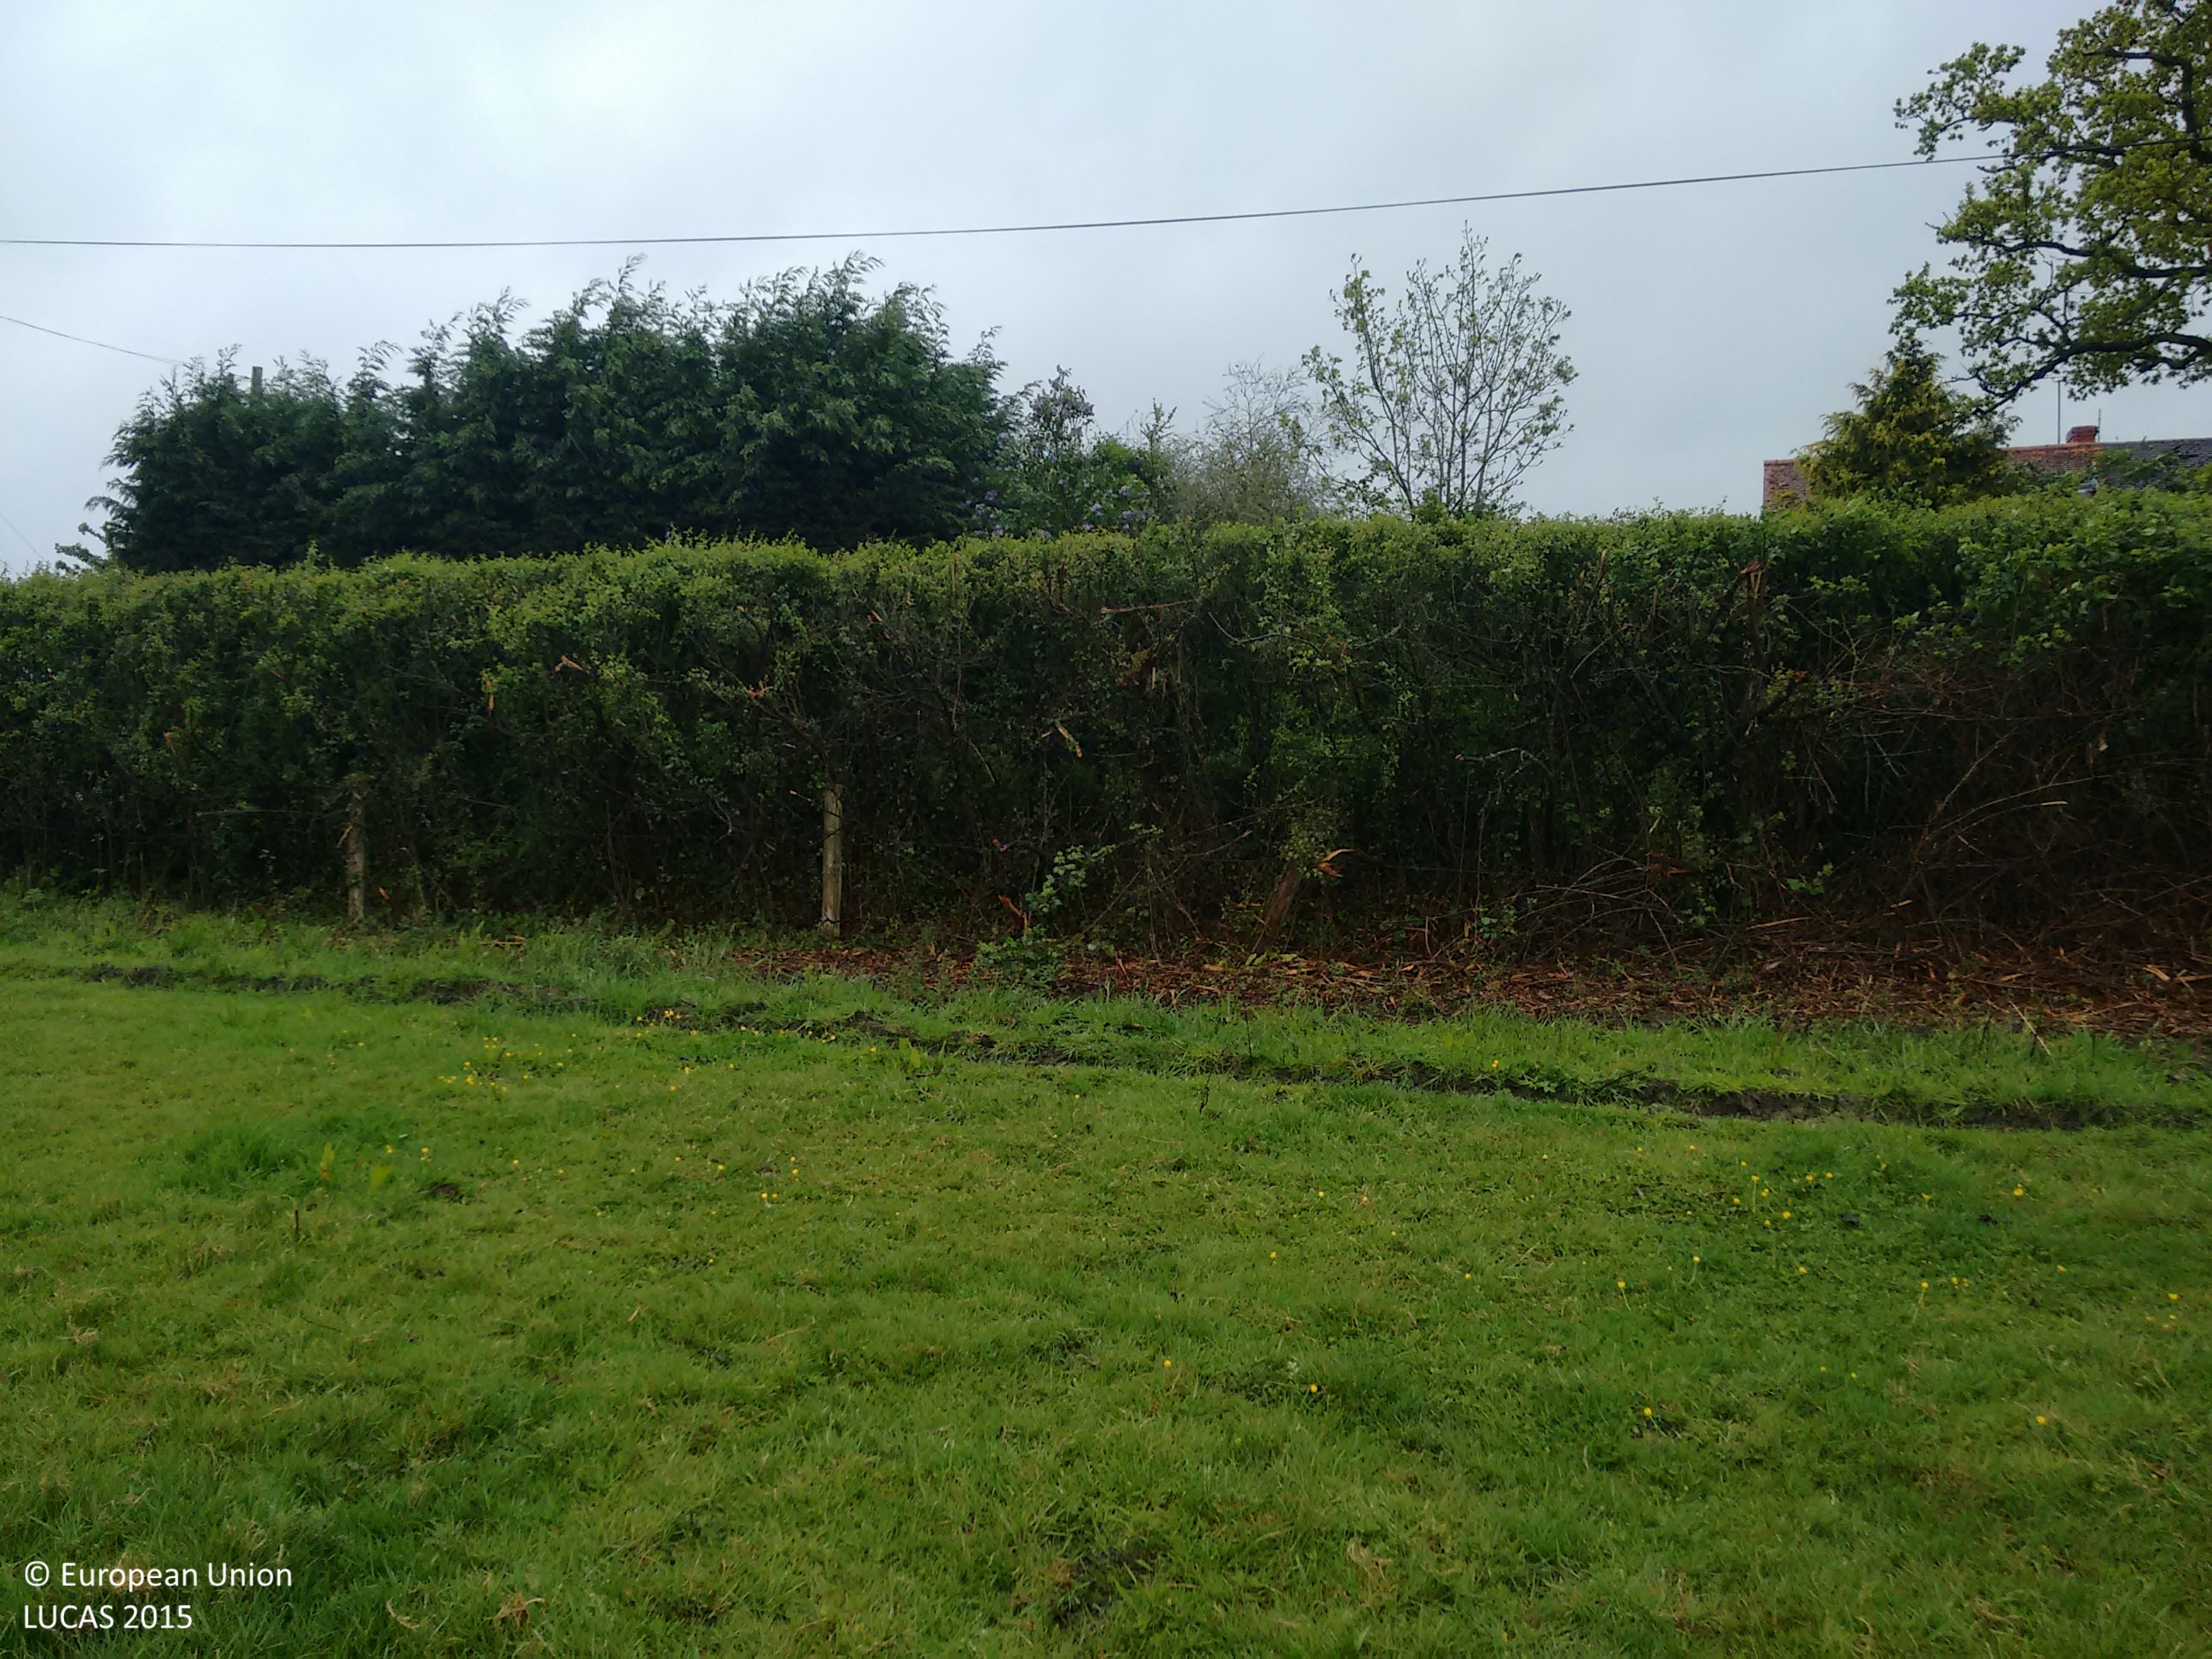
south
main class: Grassland
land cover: Grassland without tree/shrub cover
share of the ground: > 75 %
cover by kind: herbaceous plants 100 %
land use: Agriculture (excluding fallow land and kitchen gardens)
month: May
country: GB
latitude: 51.0626
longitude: -2.2914
